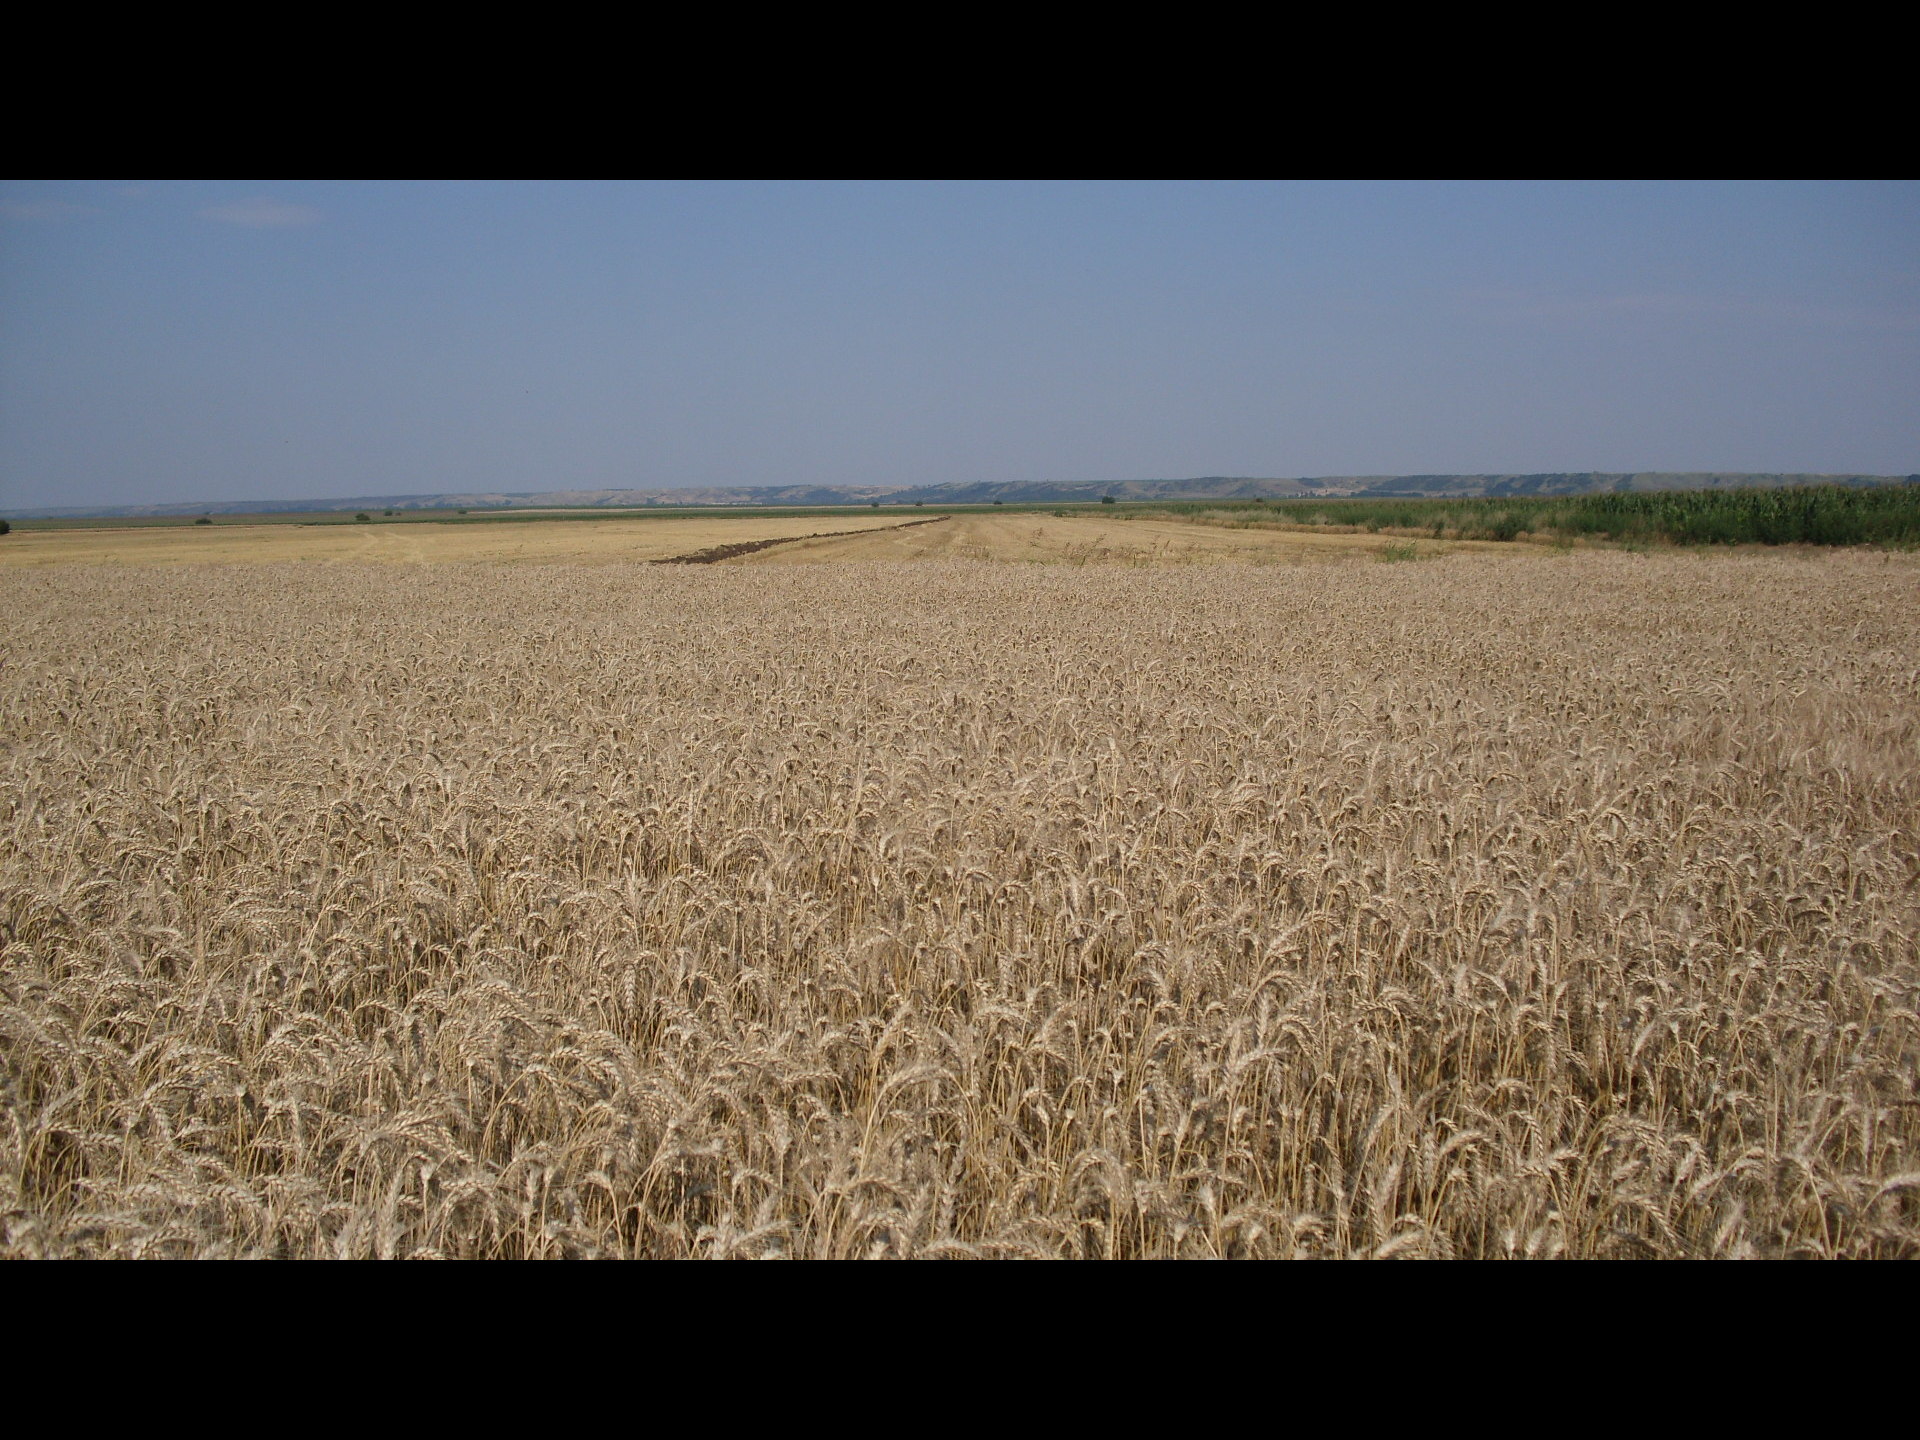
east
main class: Cropland
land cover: Common wheat
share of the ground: > 75 %
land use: Agriculture (excluding fallow land and kitchen gardens)
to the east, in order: Common wheat; Barley
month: June
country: BG
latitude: 43.6661
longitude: 23.3507
